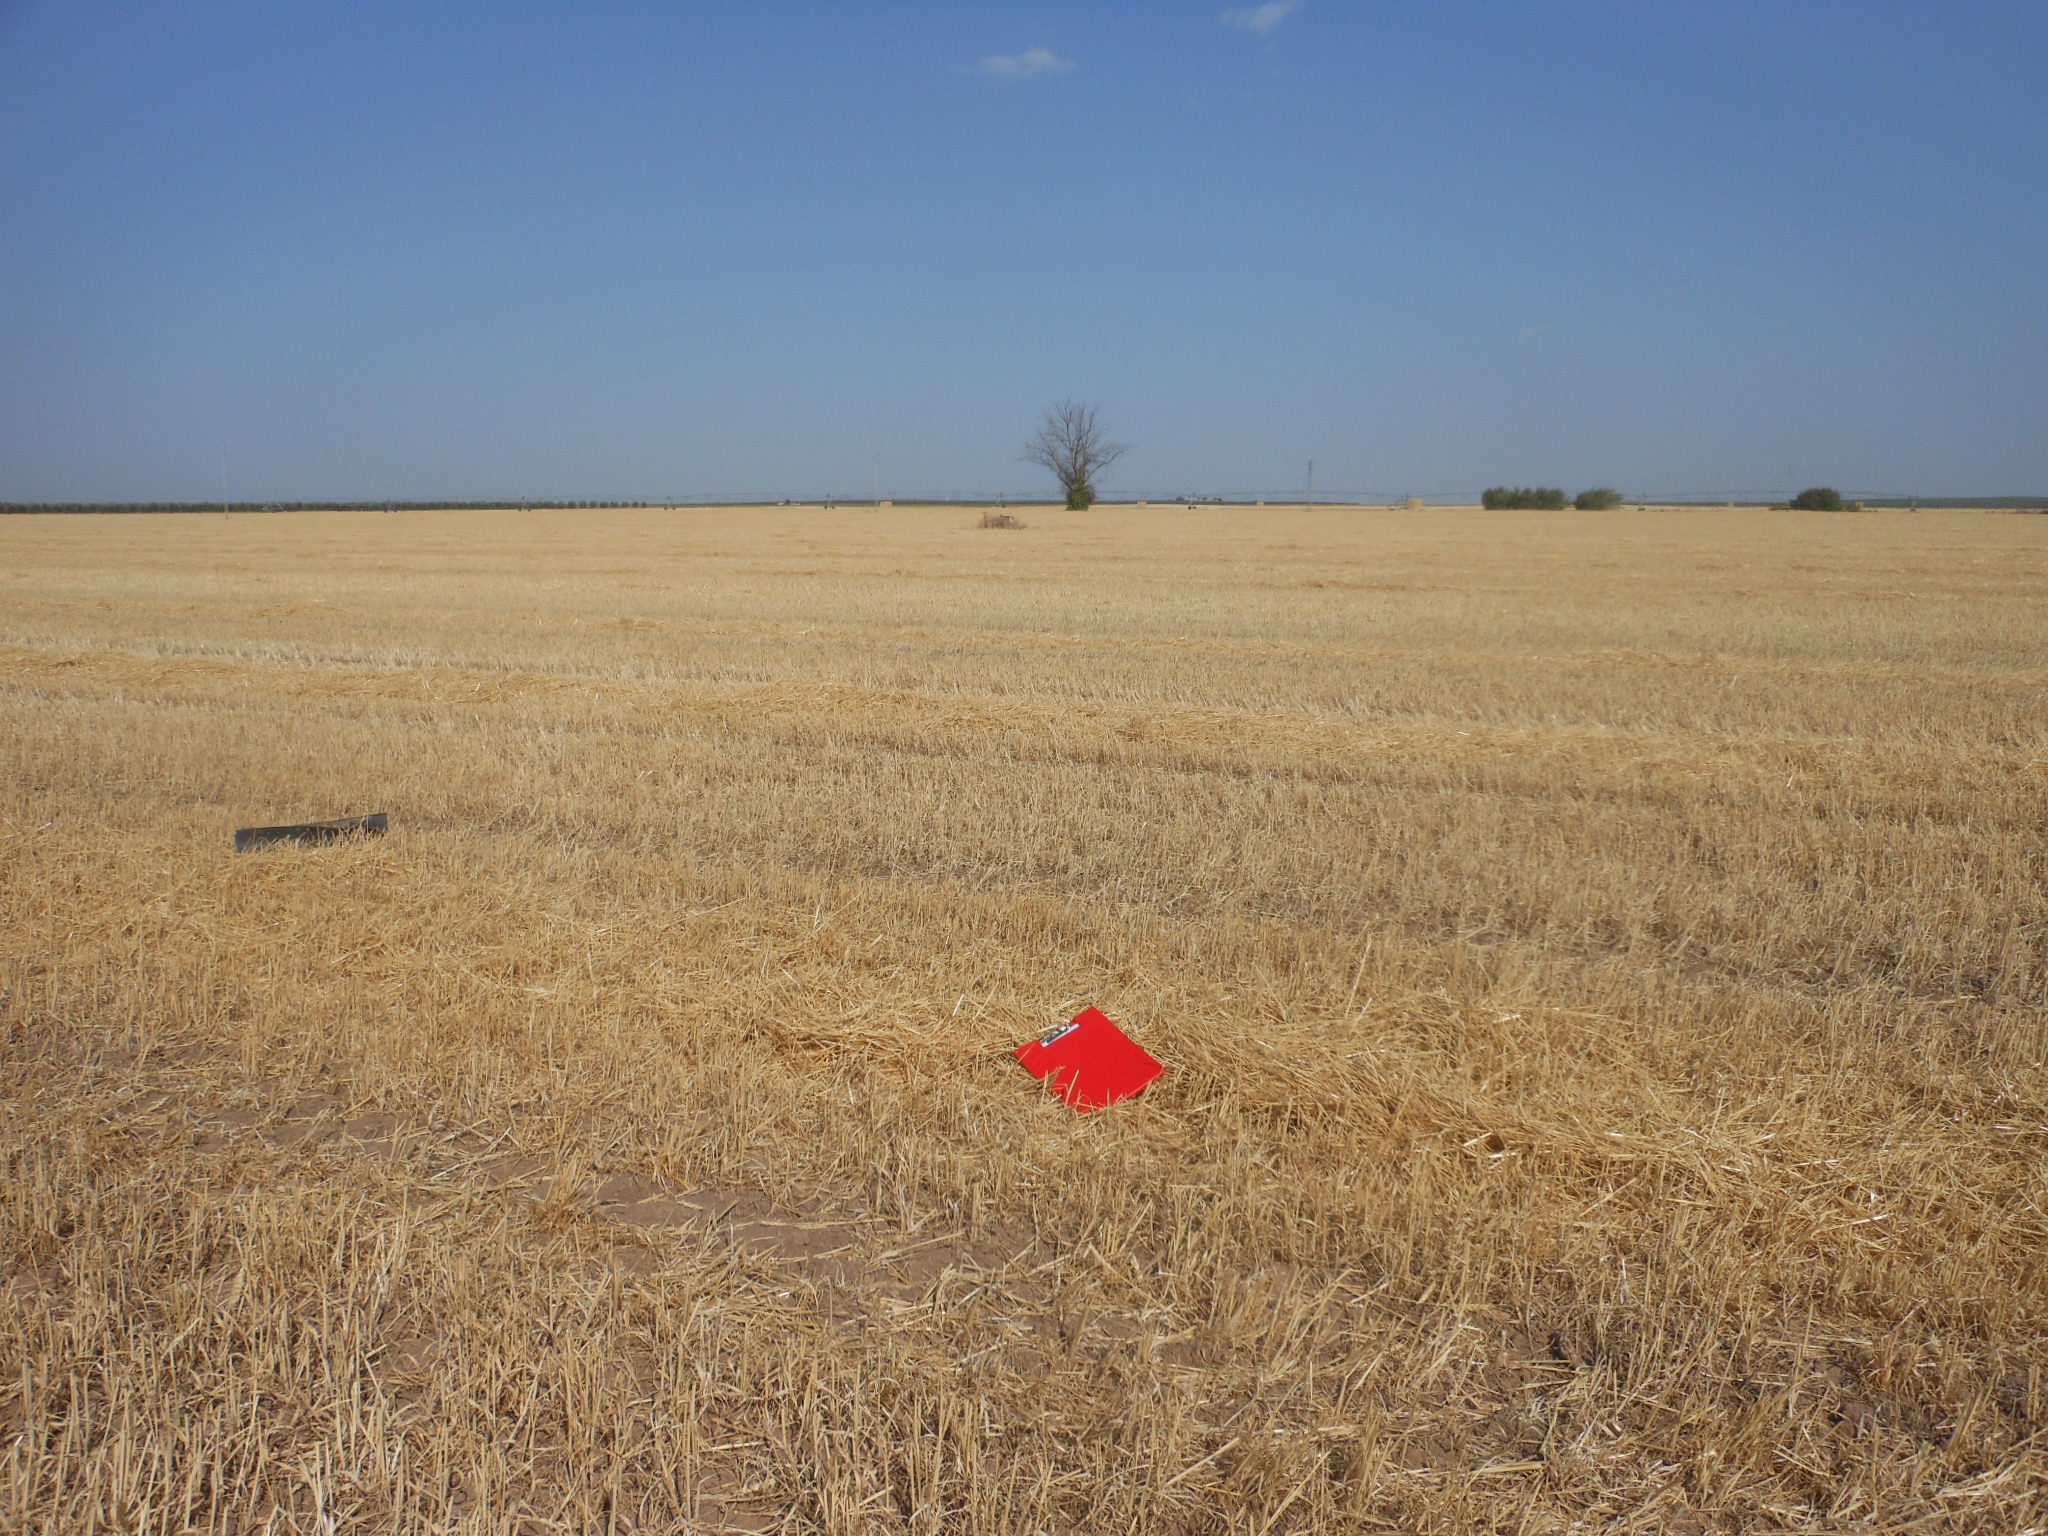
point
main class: Cropland
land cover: Common wheat
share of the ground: < 10 %
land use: Agriculture (excluding fallow land and kitchen gardens)
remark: Harvested field
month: June
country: ES
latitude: 37.3013
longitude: -5.1379
